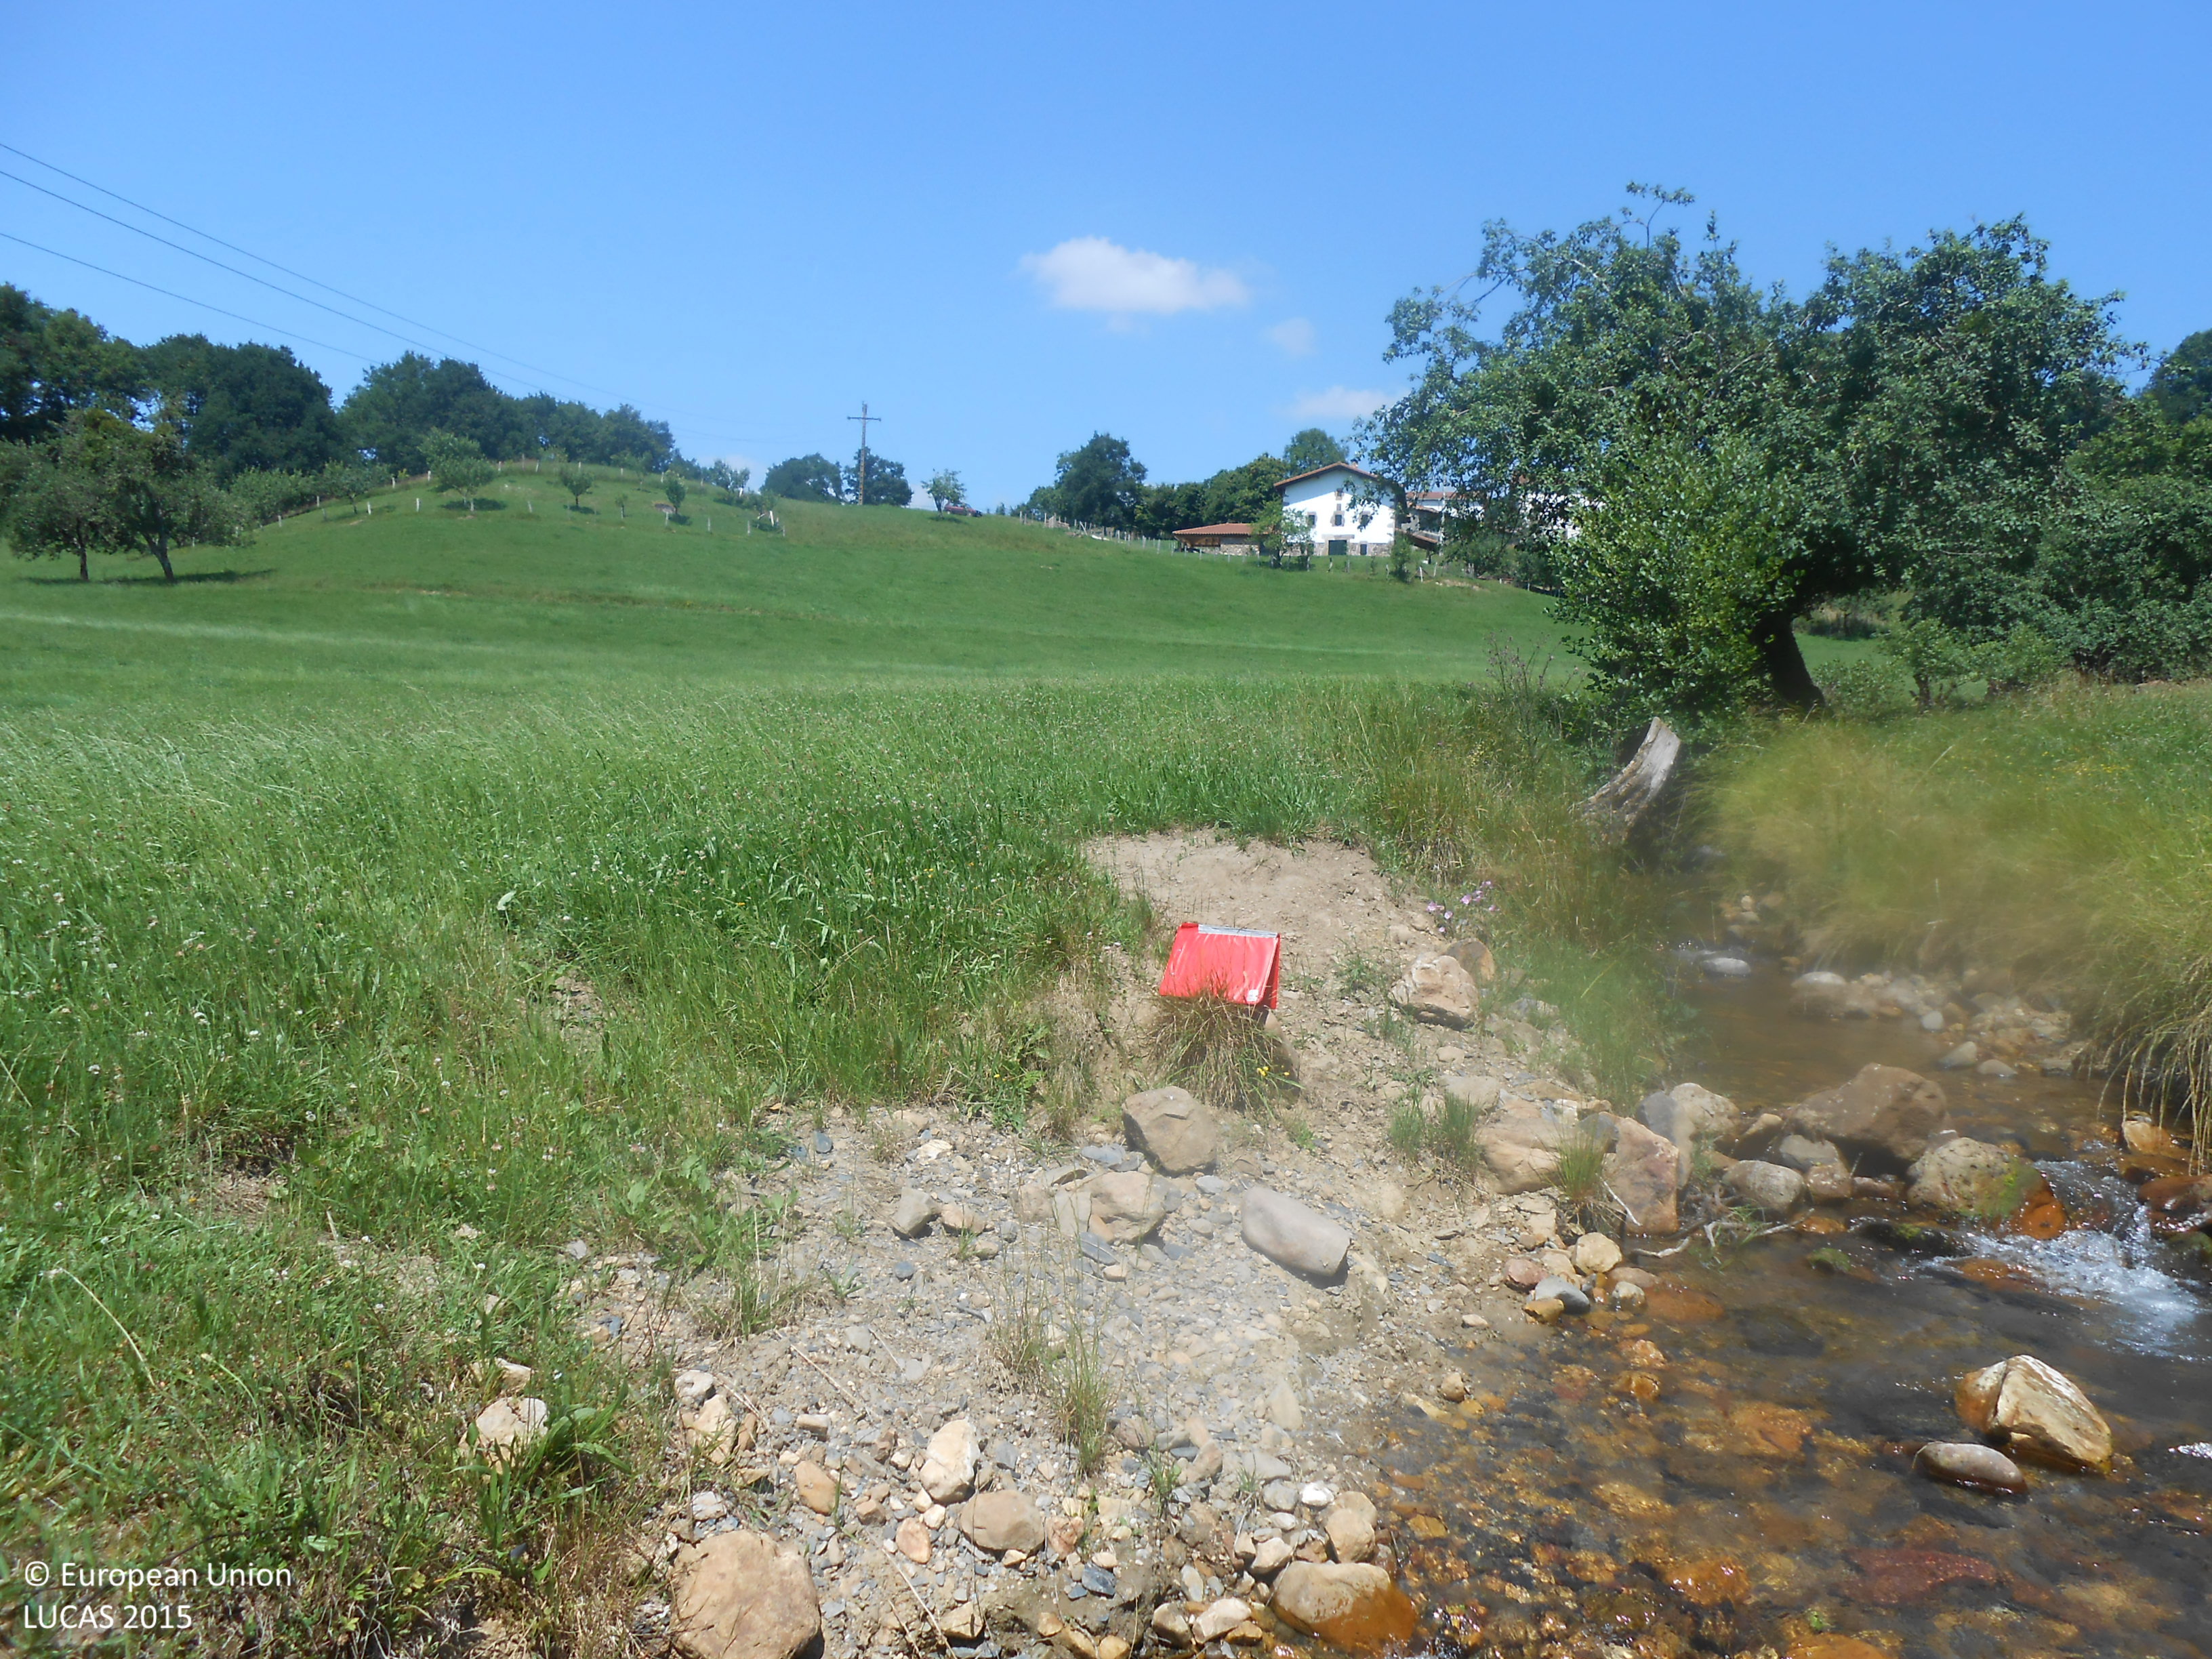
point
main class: Grassland
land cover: Grassland without tree/shrub cover
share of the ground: > 75 %
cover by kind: herbaceous plants 95 %, unconsolidated bare surface 5 %
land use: Agriculture (excluding fallow land and kitchen gardens)
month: June
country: ES
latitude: 43.1637
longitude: -1.4913
